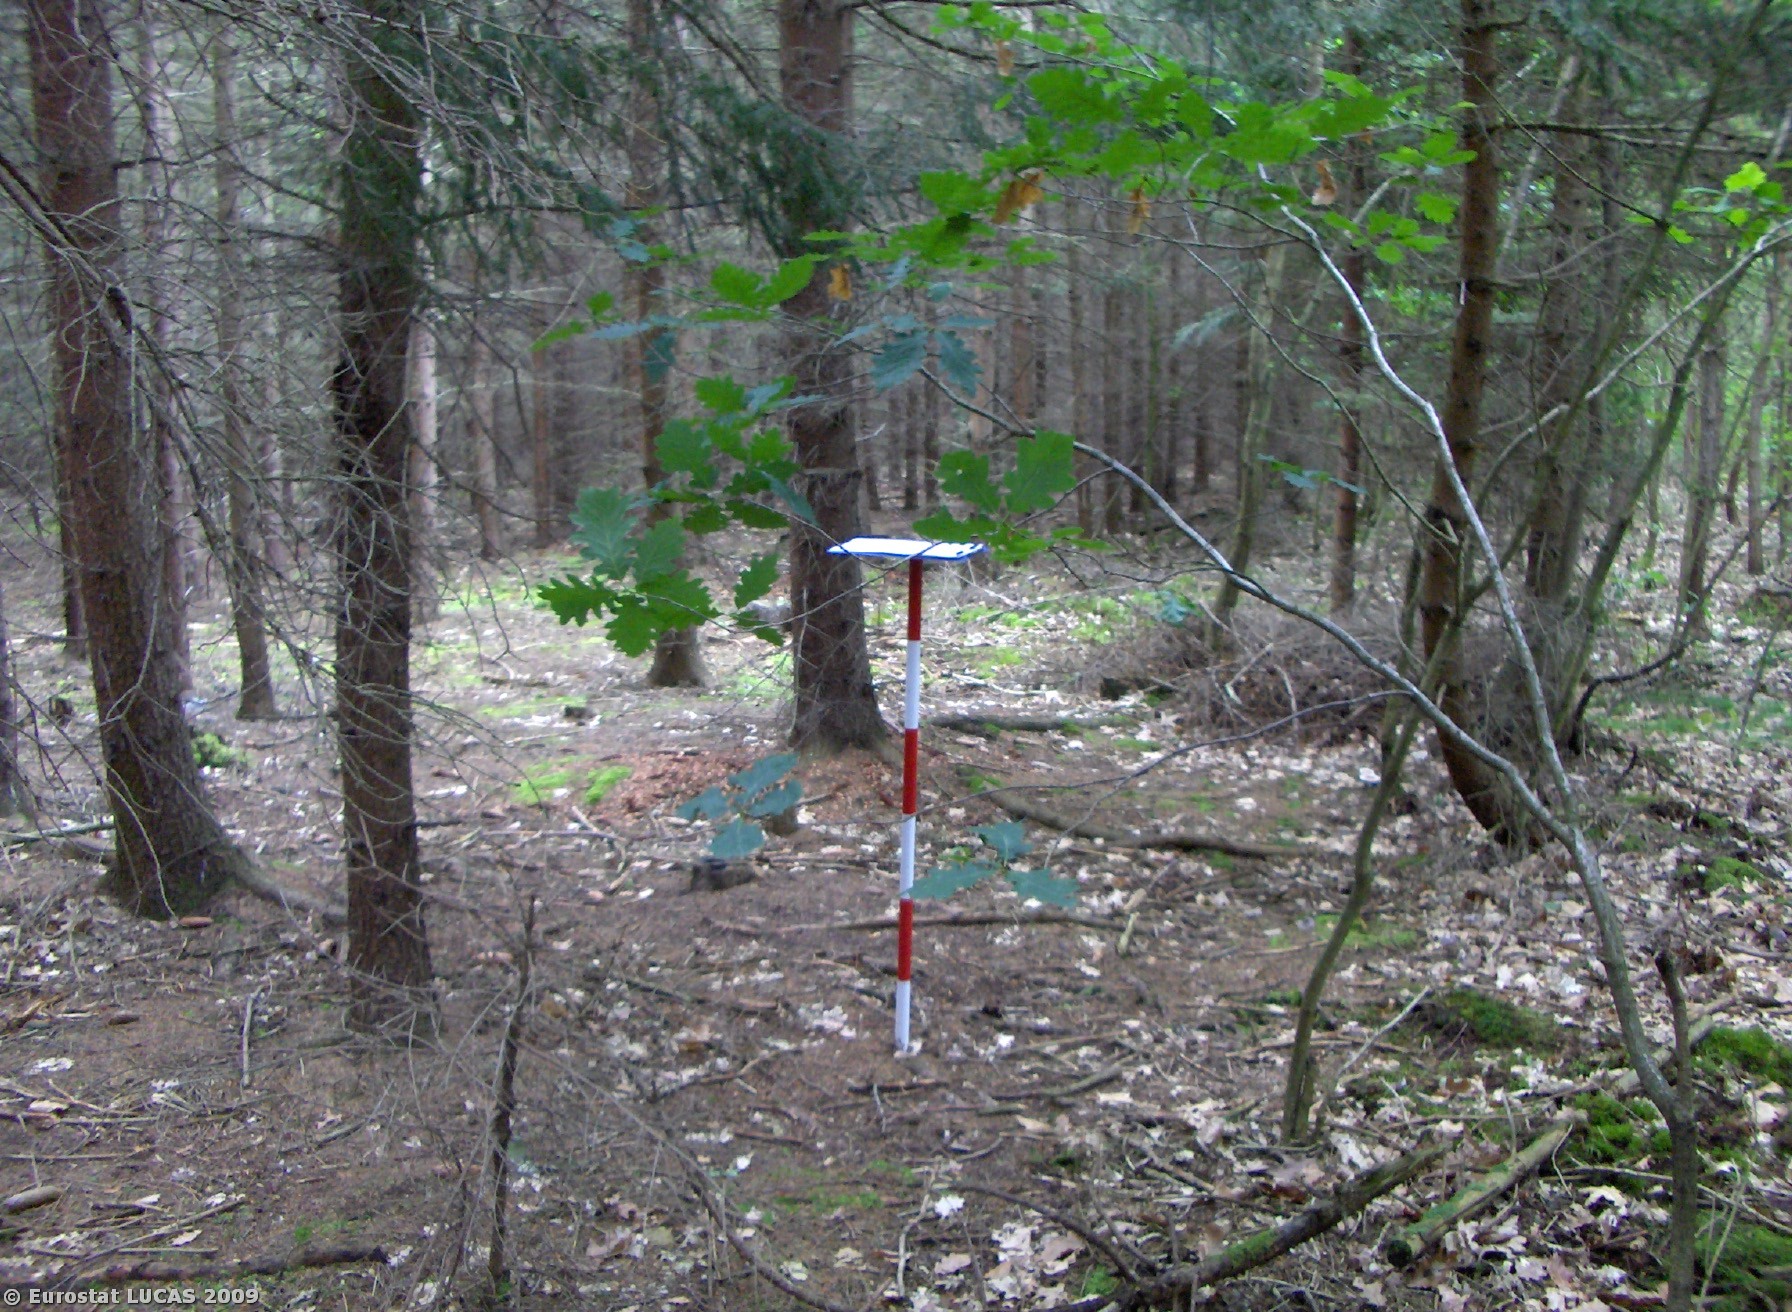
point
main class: Woodland
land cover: Coniferous woodland
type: hemiboreal forest and nemoral coniferous forest and mixed broadleaved-coniferous forest
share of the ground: > 75 %
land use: Forestry
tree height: > 5 m
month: June
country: CZ
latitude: 49.7993
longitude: 14.2386
